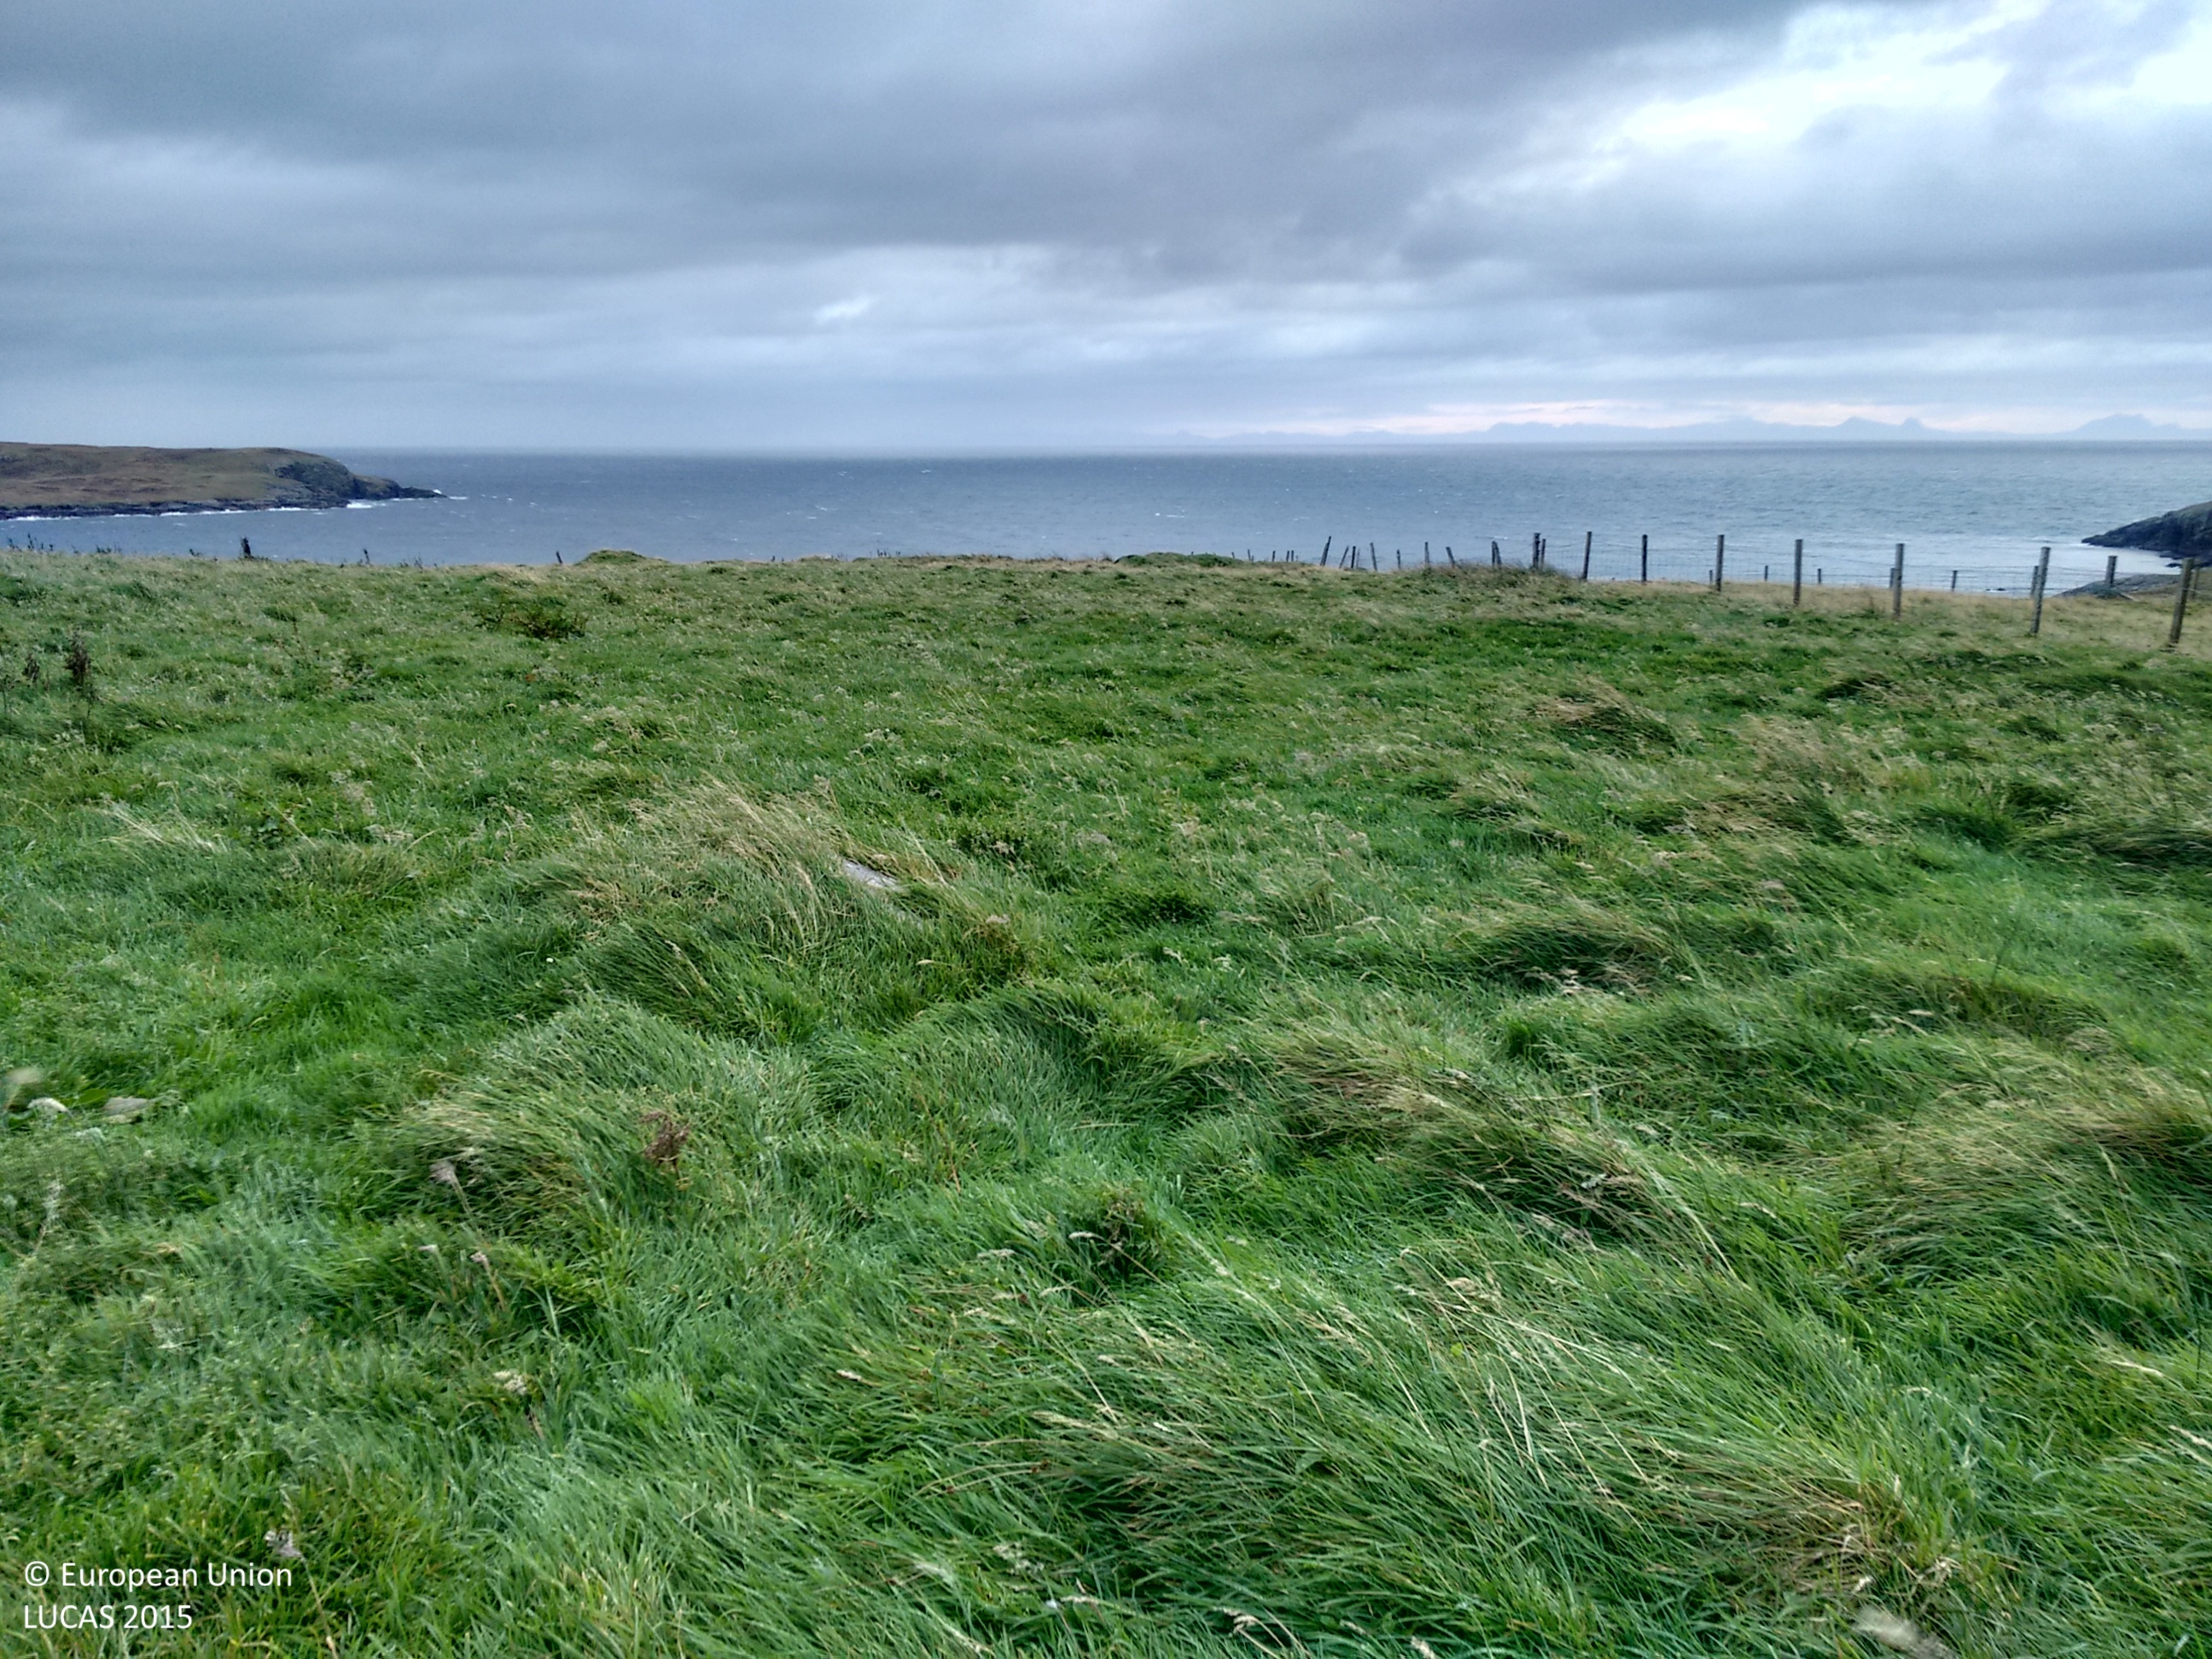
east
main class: Grassland
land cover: Grassland without tree/shrub cover
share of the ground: > 75 %
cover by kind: herbaceous plants 100 %
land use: Agriculture (excluding fallow land and kitchen gardens)
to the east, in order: Grassland without tree/shrub cover; Fences; Grassland without tree/shrub cover; Rock outcrops; Grassland without tree/shrub cover; Fences; Grassland without tree/shrub cover; Rock outcrops; Grassland without tree/shrub cover; Ditches and canals; Grassland without tree/shrub cover
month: October
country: GB
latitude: 58.2442
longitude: -6.1585
